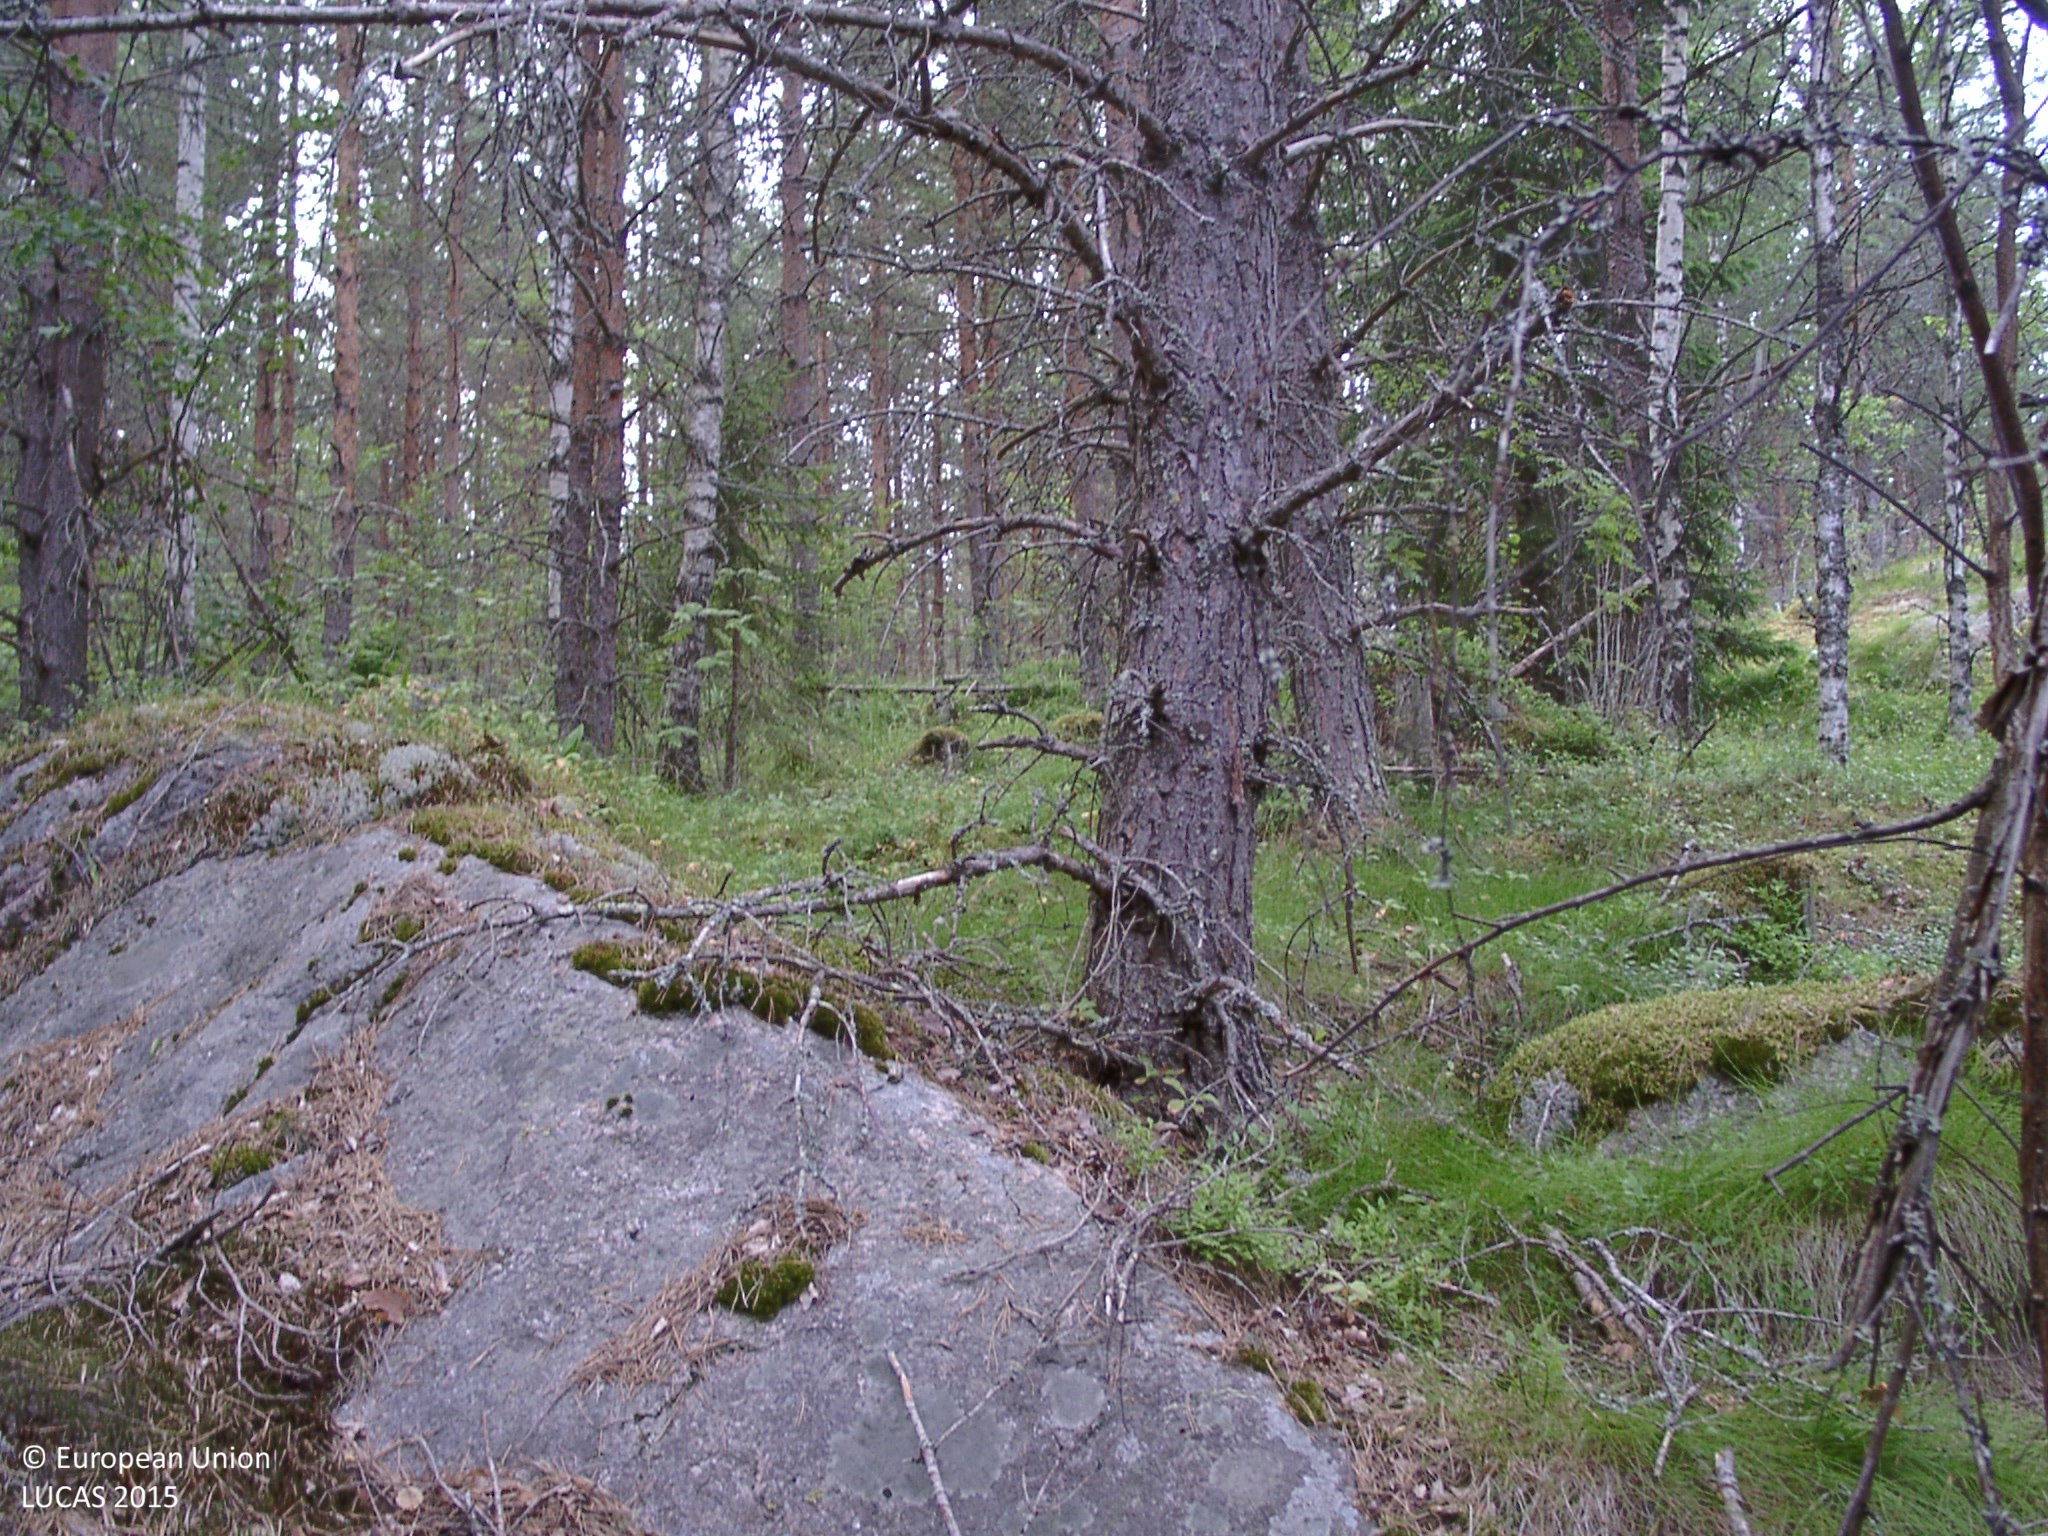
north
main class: Woodland
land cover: Pine dominated mixed woodland
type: boreal forest
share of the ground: 50 - 75 %
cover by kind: coniferous forest trees 45 %, broadleaved forest trees 25 %, herbaceous plants 10 %, lichens and mosses 10 %, shrubs 5 %, consolidated bare surface 5 %
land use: Forestry
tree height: > 5 m
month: July
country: FI
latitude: 61.7734
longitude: 24.7137
